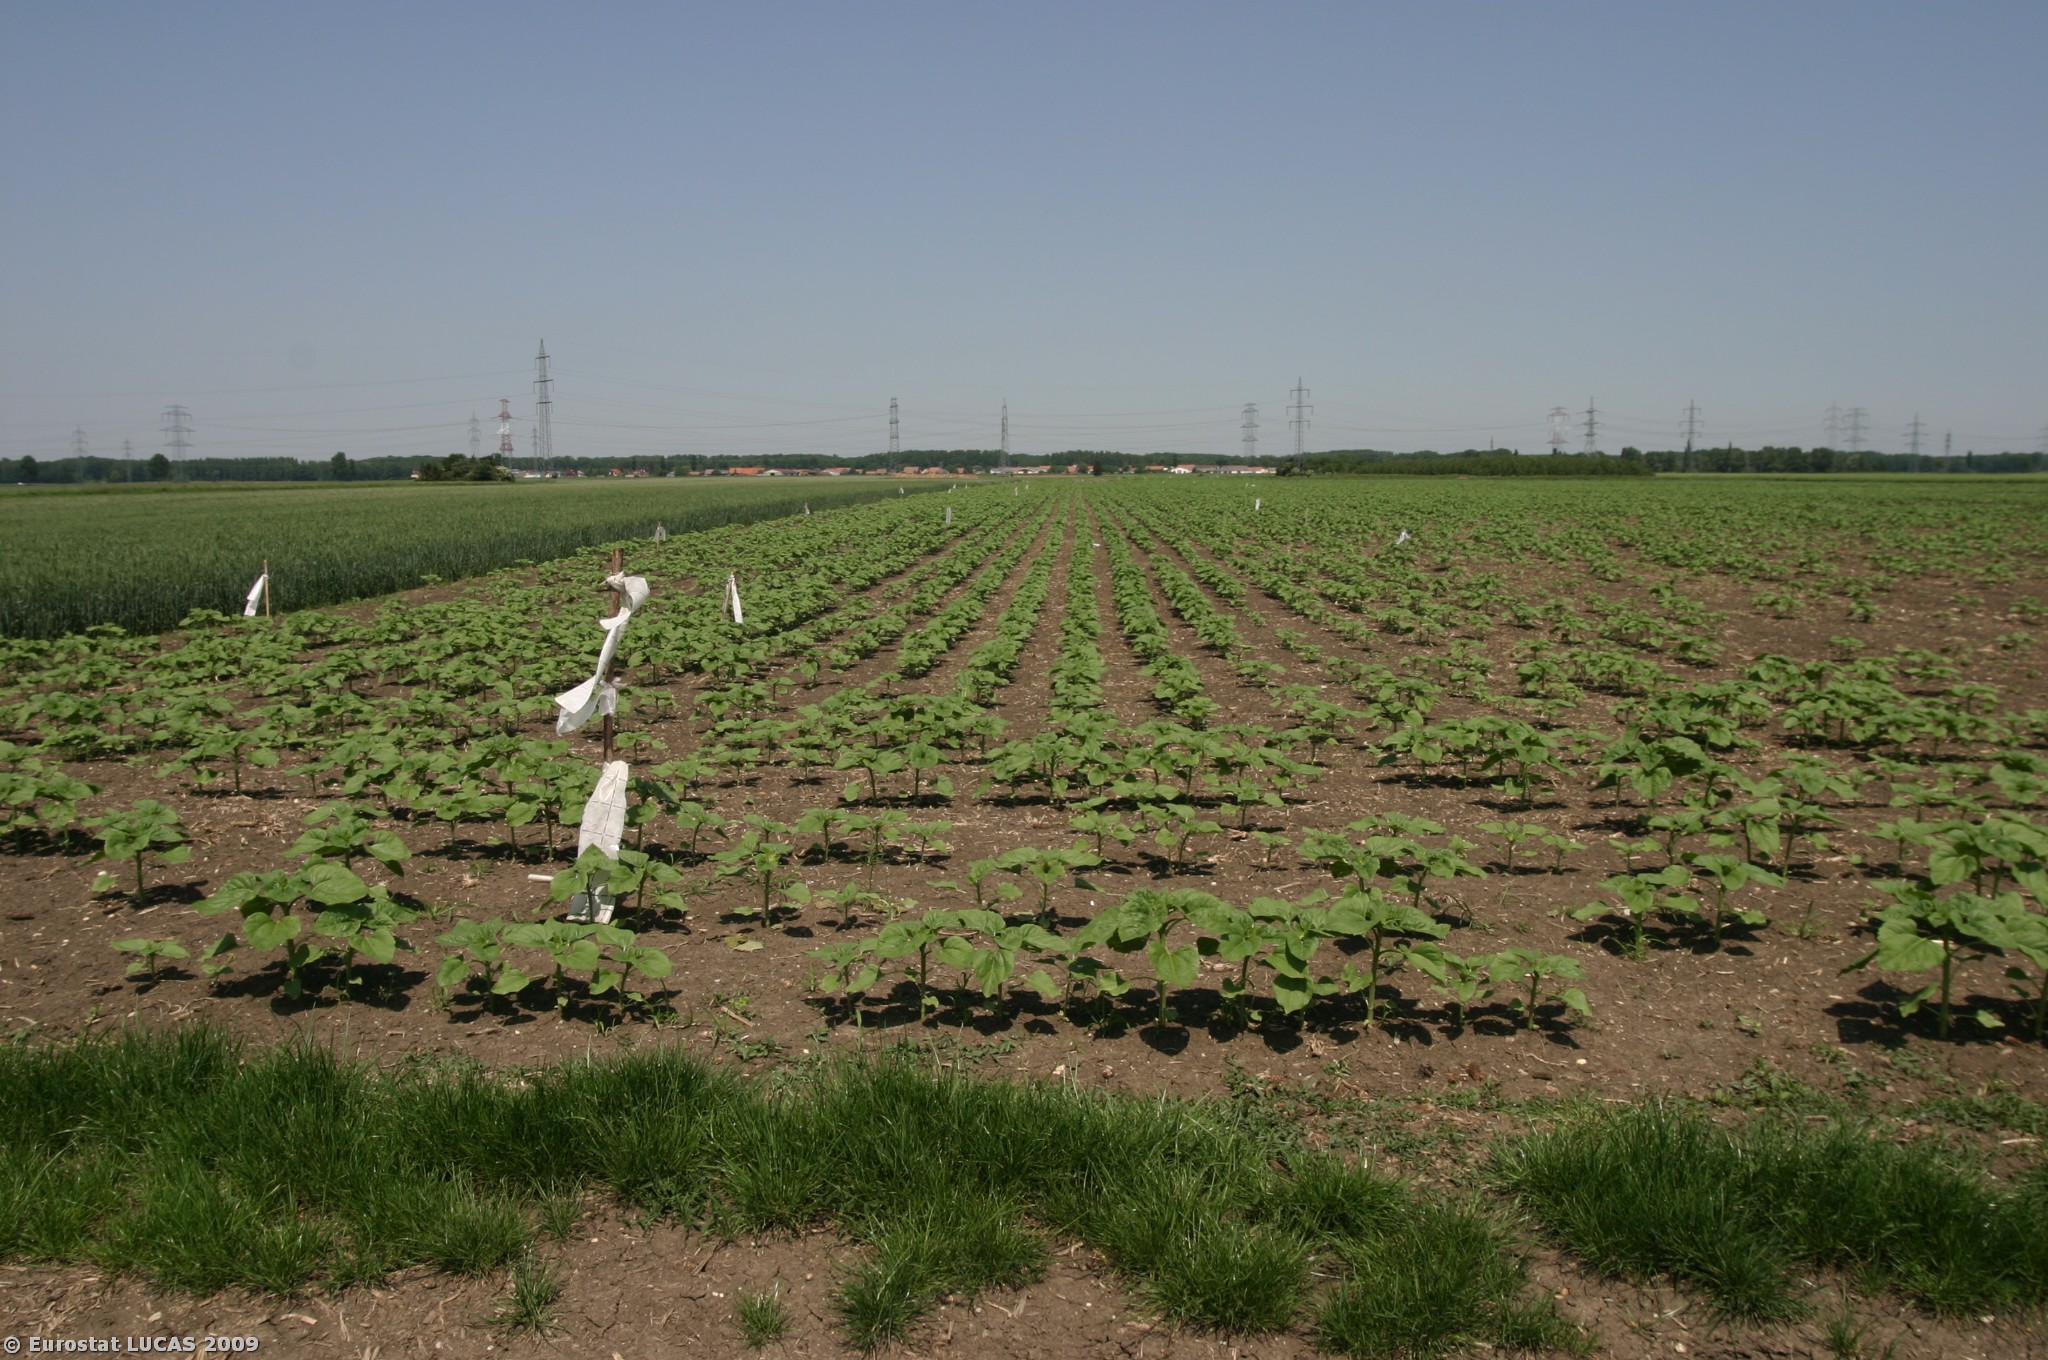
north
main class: Cropland
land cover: Common wheat
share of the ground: > 75 %
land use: Agriculture (excluding fallow land and kitchen gardens)
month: May
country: AT
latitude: 48.3139
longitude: 15.9775
